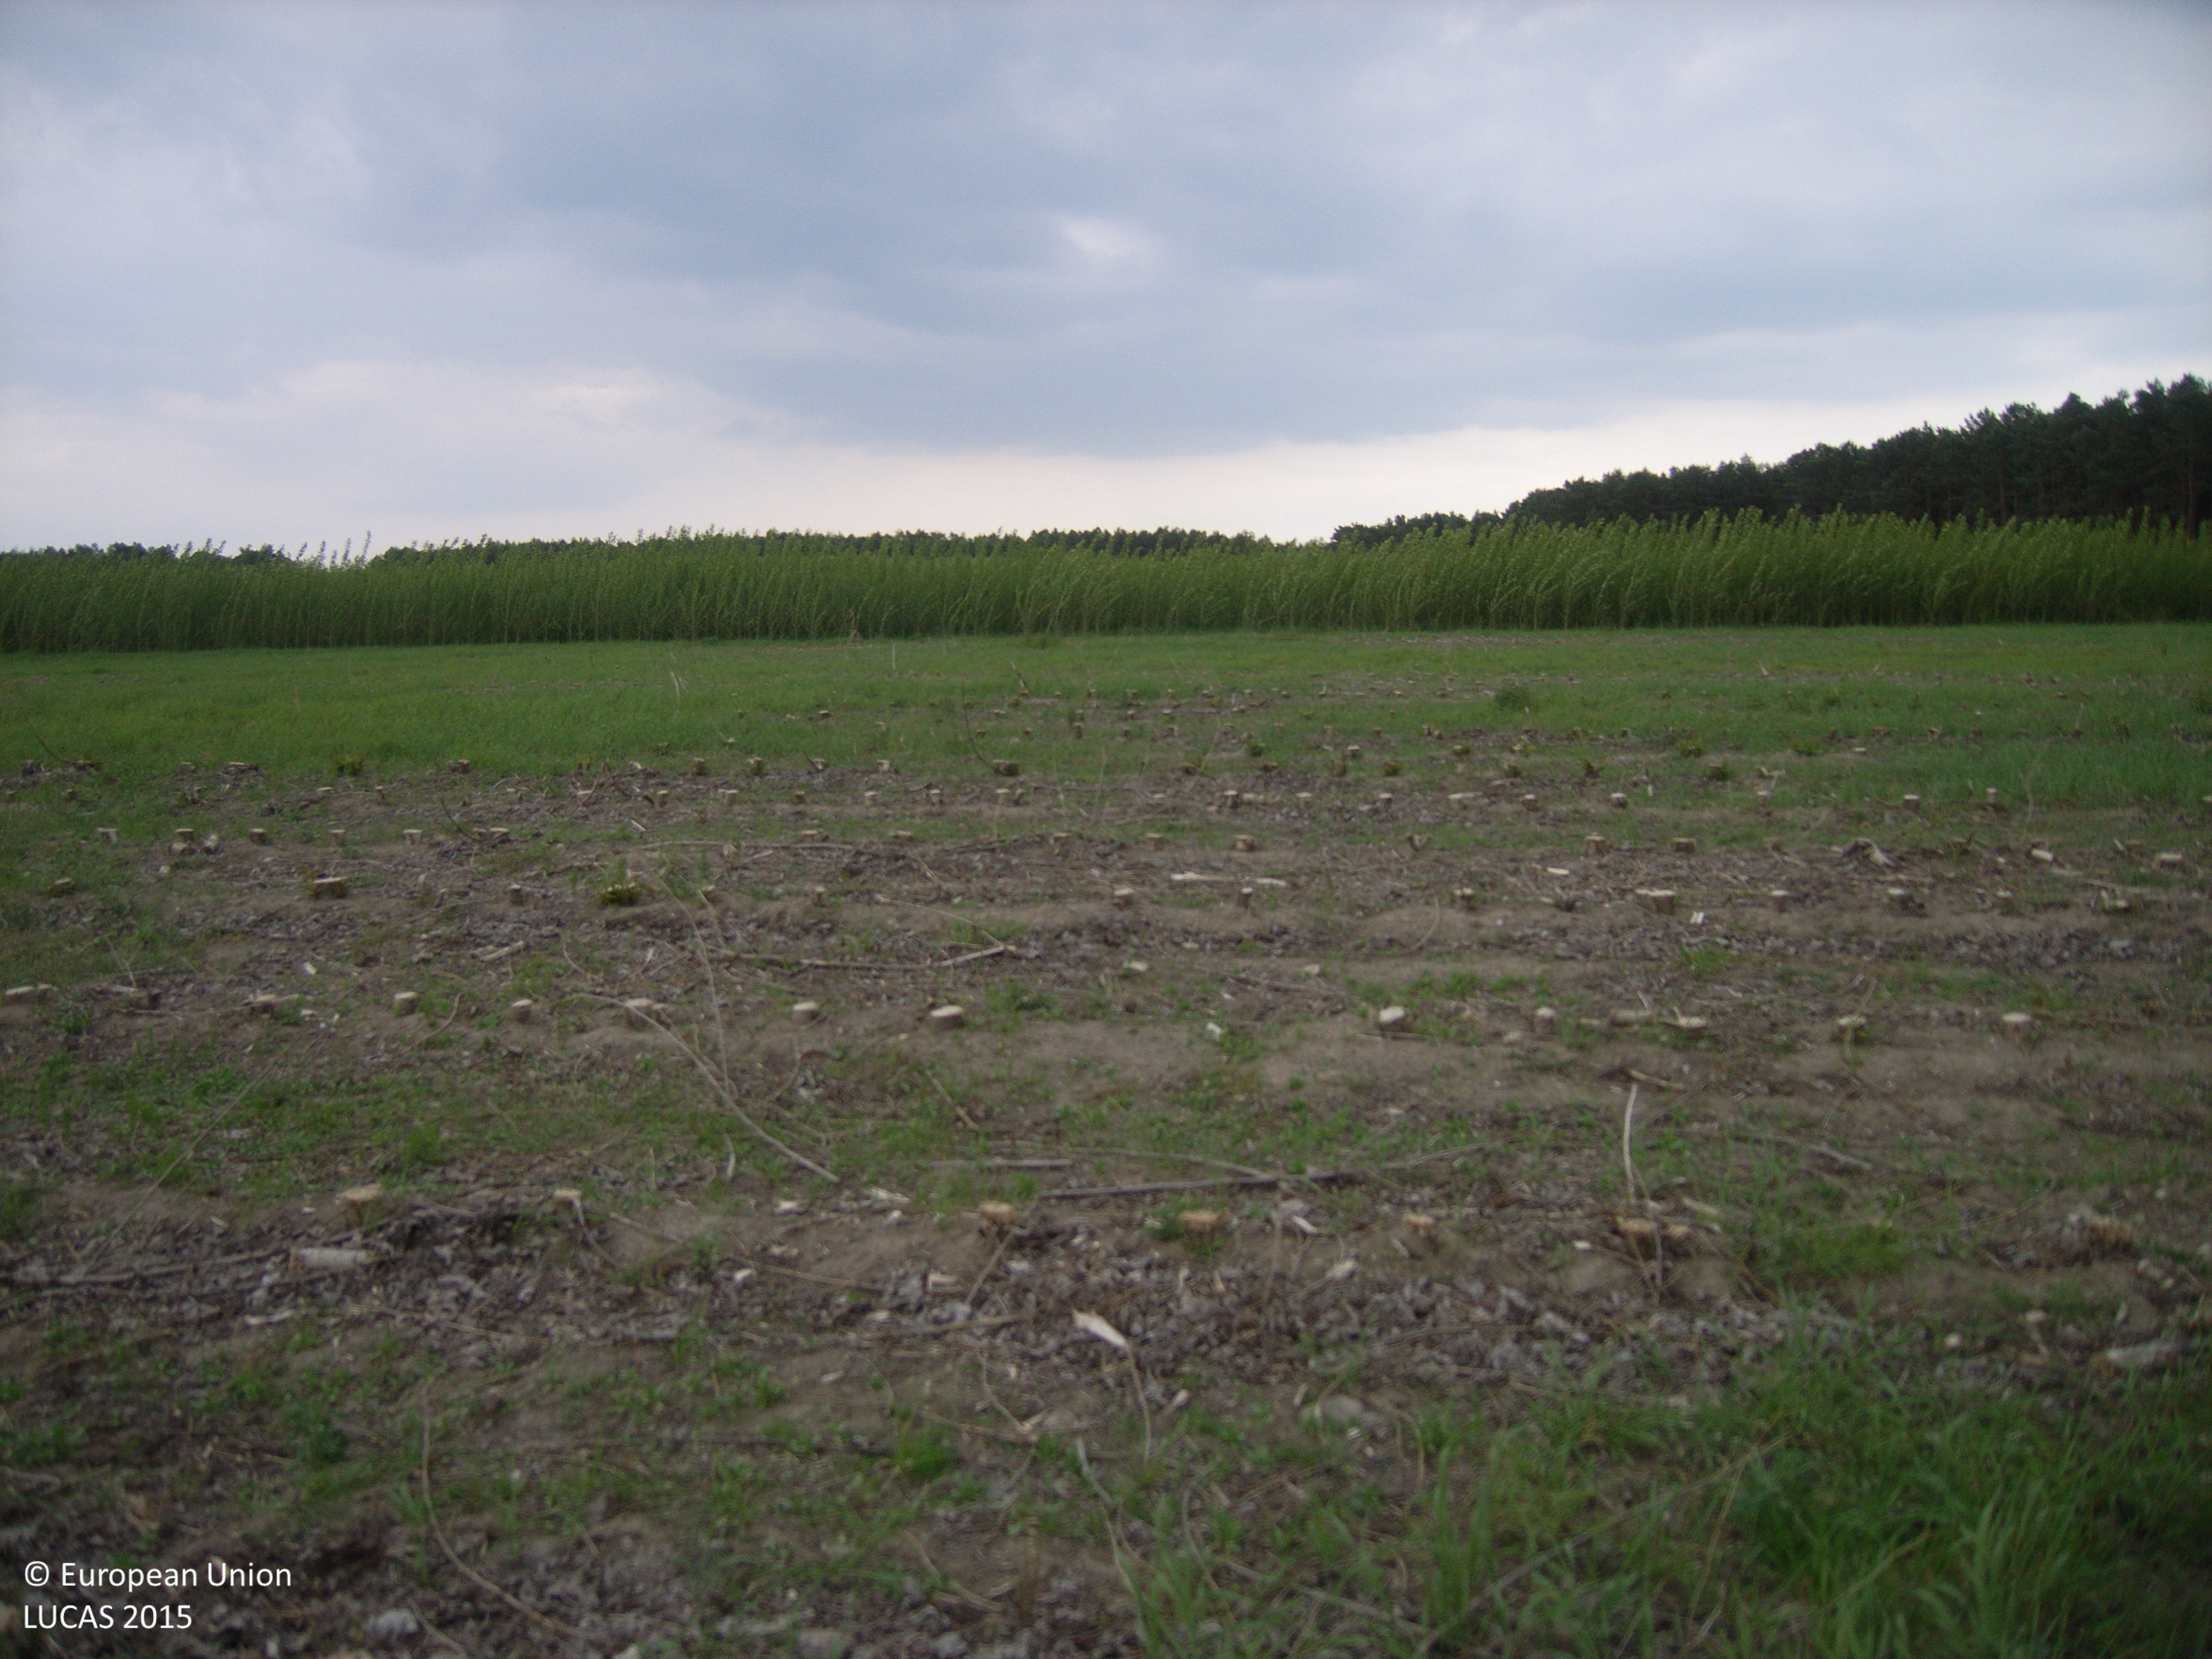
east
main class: Grassland
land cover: Grassland with sparse tree/shrub cover
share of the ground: > 75 %
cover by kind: herbaceous plants 90 %, broadleaved forest trees 5 %, shrubs 5 %
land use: Forestry
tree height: > 5 m
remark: Clear cut
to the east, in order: Grassland with sparse tree/shrub cover; Broadleaved woodland
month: May
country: DE
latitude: 52.1699
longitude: 14.4025
